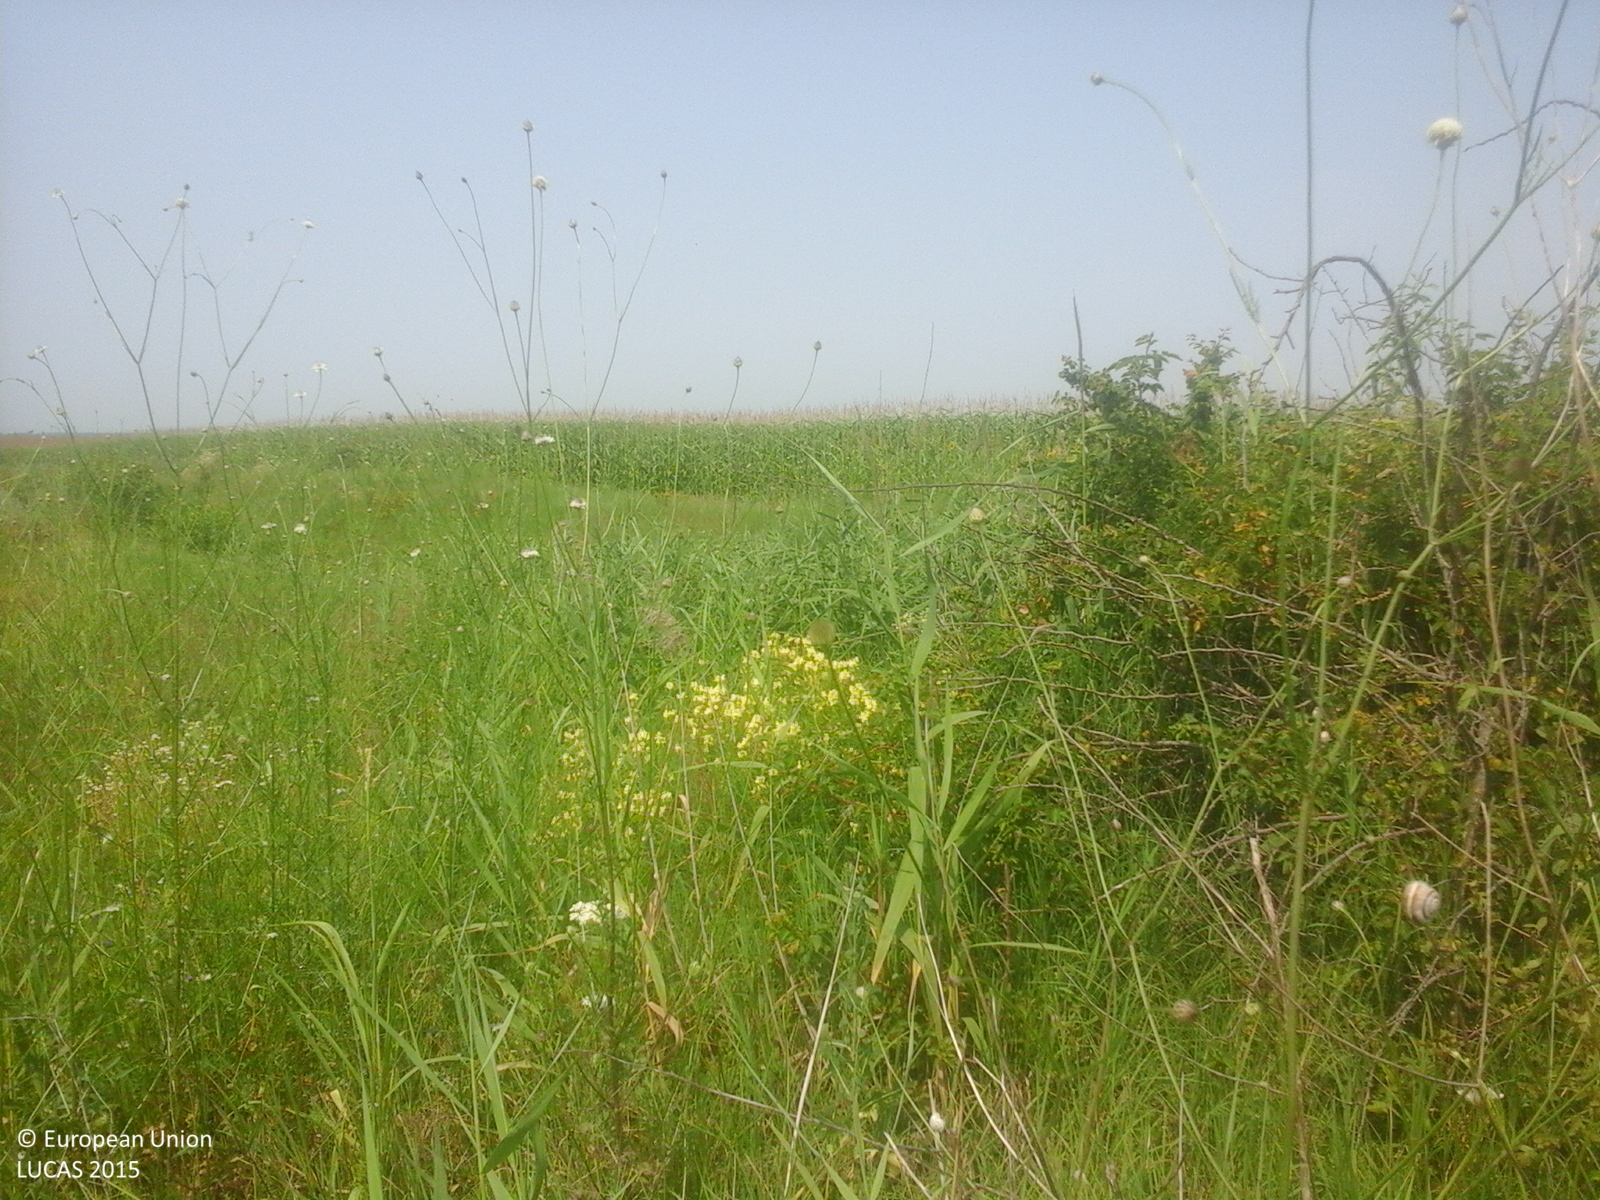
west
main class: Cropland
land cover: Maize
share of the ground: > 75 %
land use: Agriculture (excluding fallow land and kitchen gardens)
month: July
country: RO
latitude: 44.7562
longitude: 26.3212
